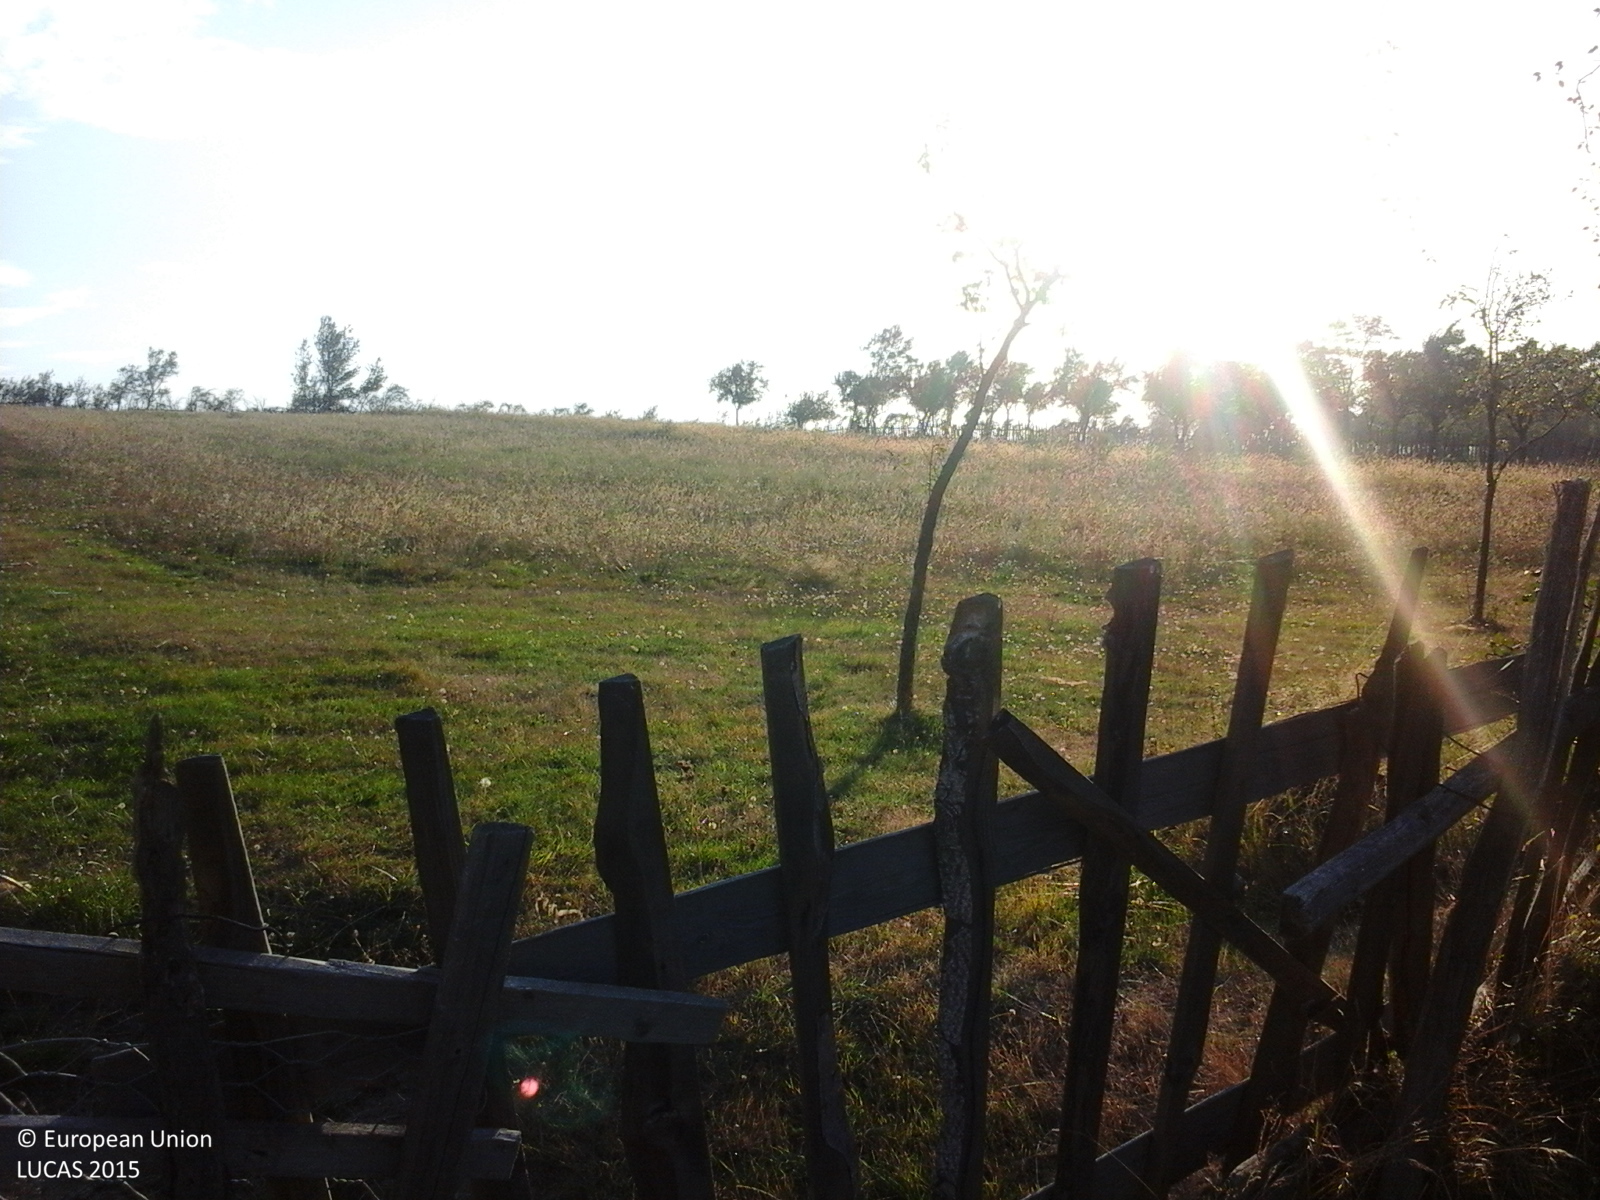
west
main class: Grassland
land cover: Grassland without tree/shrub cover
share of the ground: > 75 %
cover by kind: herbaceous plants 100 %
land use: Agriculture (excluding fallow land and kitchen gardens)
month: September
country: RO
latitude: 45.2691
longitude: 22.3412
